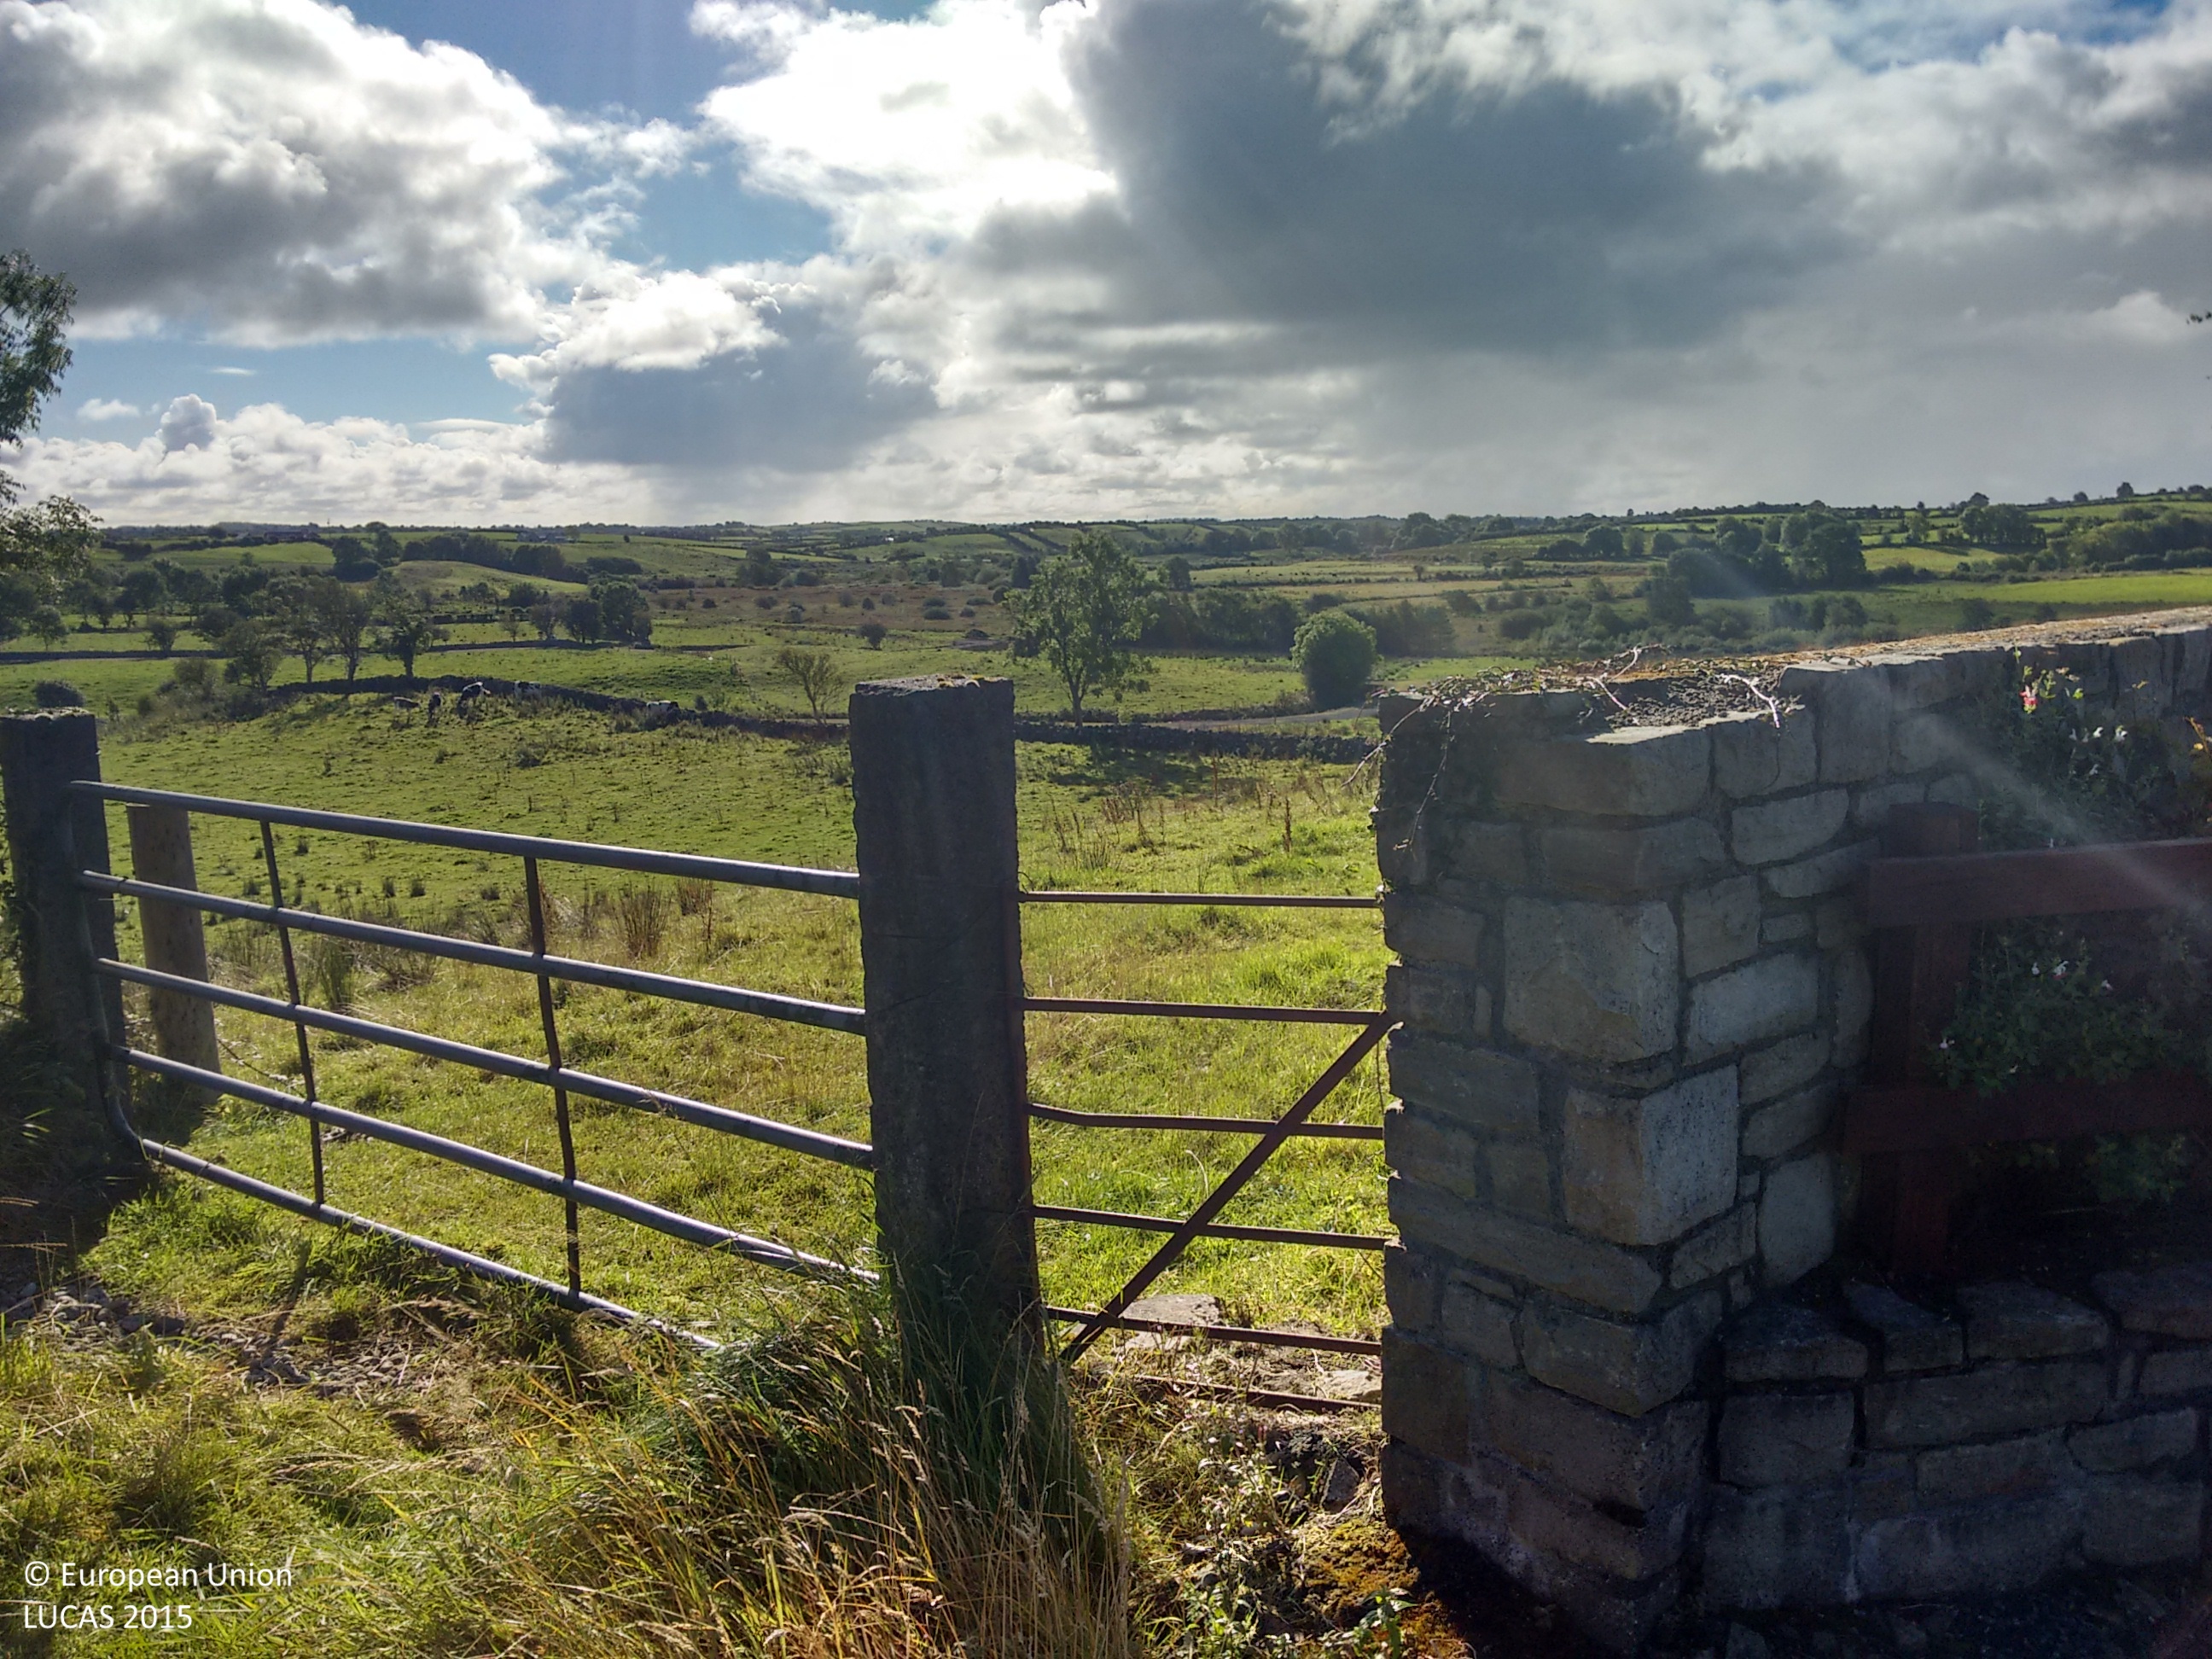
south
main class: Grassland
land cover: Grassland without tree/shrub cover
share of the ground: > 75 %
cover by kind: herbaceous plants 100 %
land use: Agriculture (excluding fallow land and kitchen gardens)
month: September
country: IE
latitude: 53.8388
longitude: -9.2325
